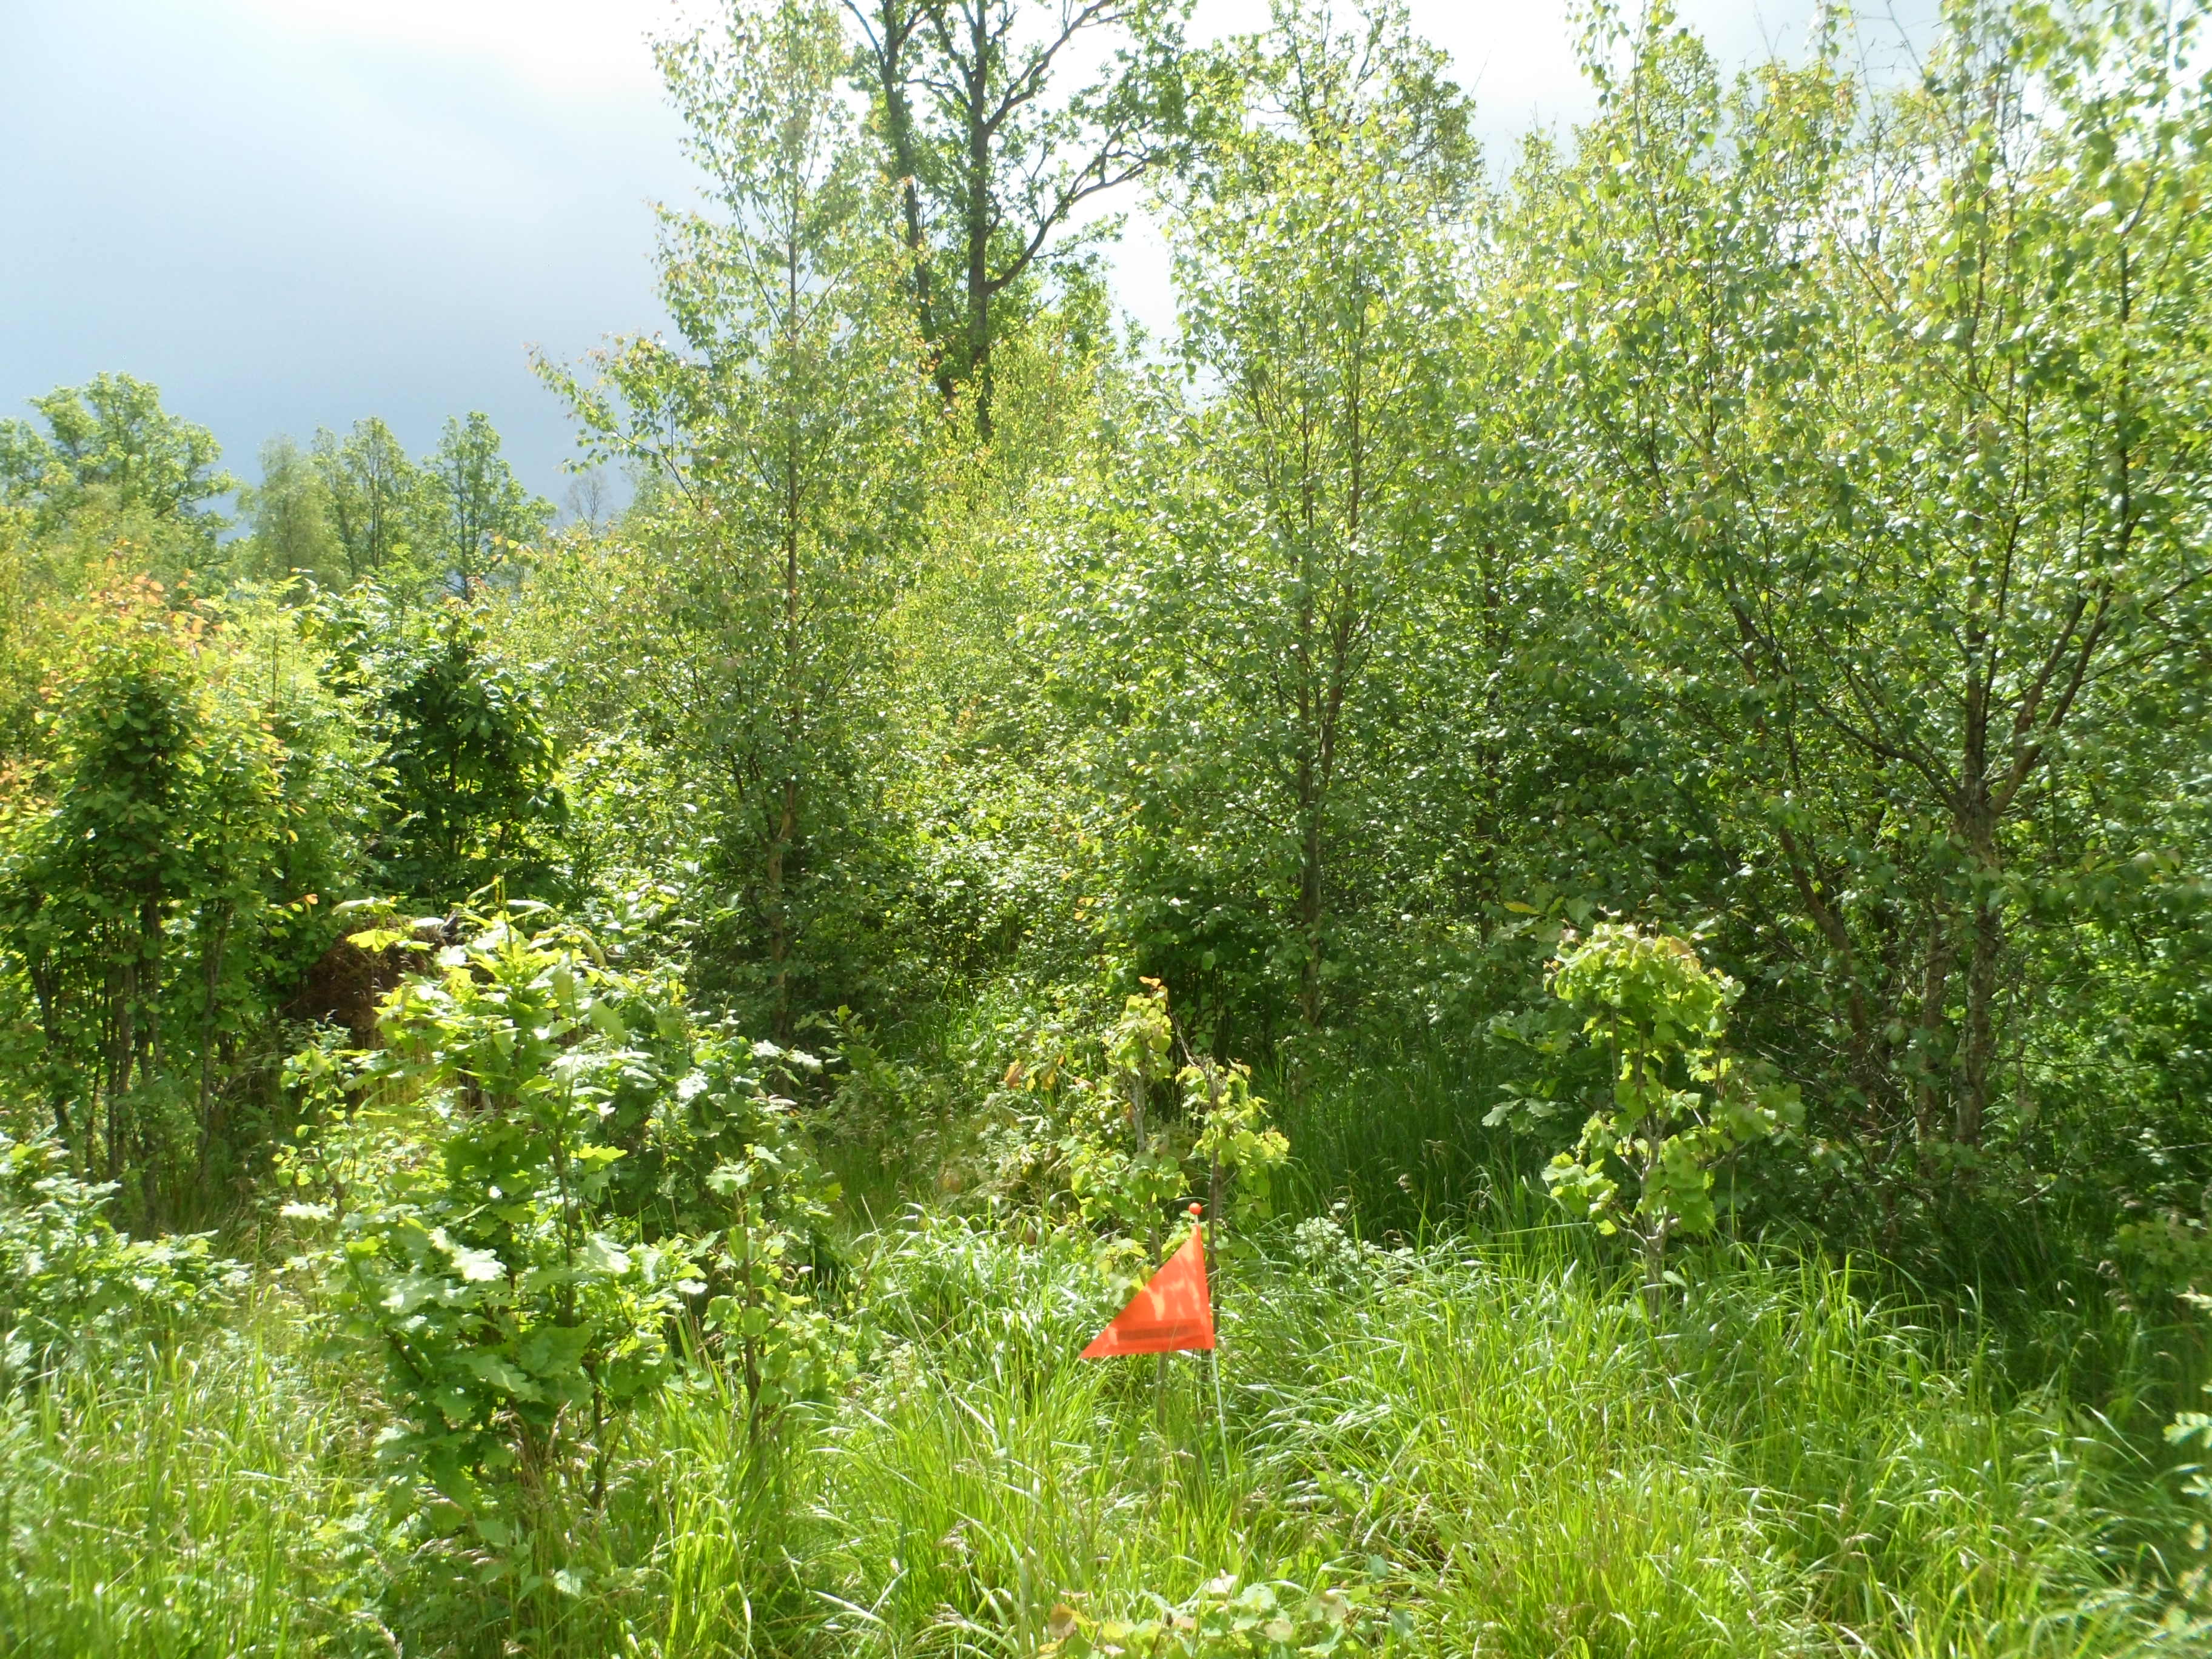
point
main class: Woodland
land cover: Broadleaved woodland
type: boreal forest
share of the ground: 50 - 75 %
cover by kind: broadleaved forest trees 65 %, herbaceous plants 30 %, coniferous forest trees 5 %
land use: Forestry
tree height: < 5 m
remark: Clear cut
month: June
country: SE
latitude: 56.9445
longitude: 14.2869
